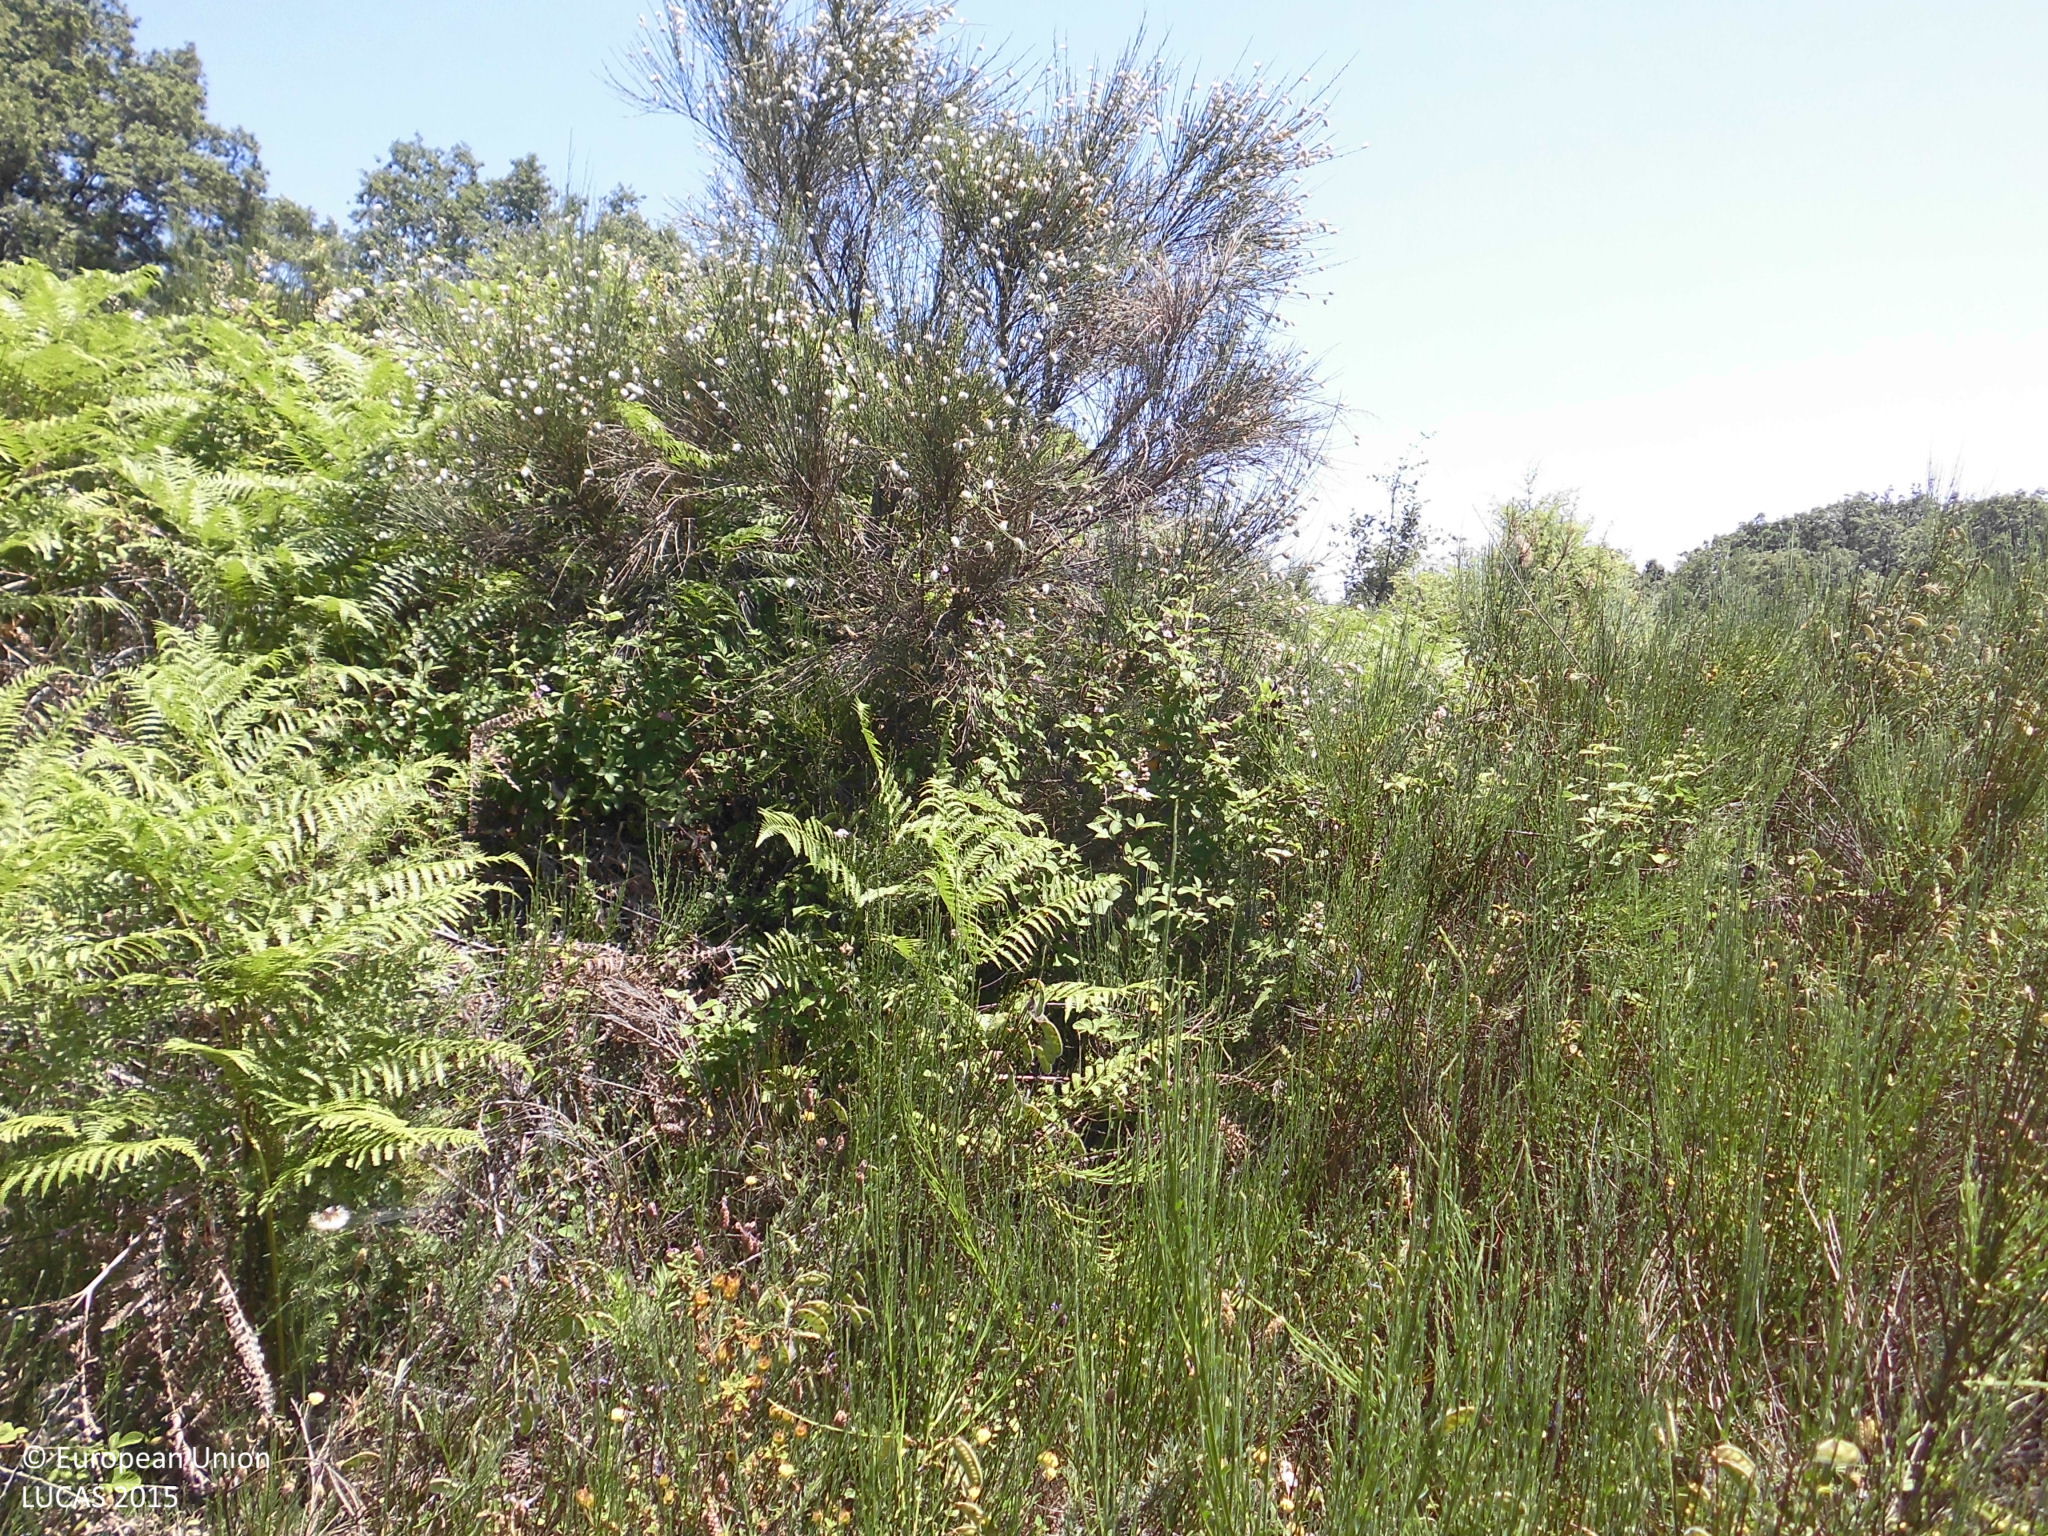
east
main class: Woodland
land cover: Broadleaved woodland
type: thermophilous deciduous forest
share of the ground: 10 - 25 %
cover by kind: shrubs 90 %, broadleaved forest trees 10 %
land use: Forestry
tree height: > 5 m
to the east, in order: Broadleaved woodland; Tracks; Abandoned hedges; Olive groves; Nuts trees; Dry stone walls; Broadleaved woodland
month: June
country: ES
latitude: 40.1309
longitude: -5.4942
